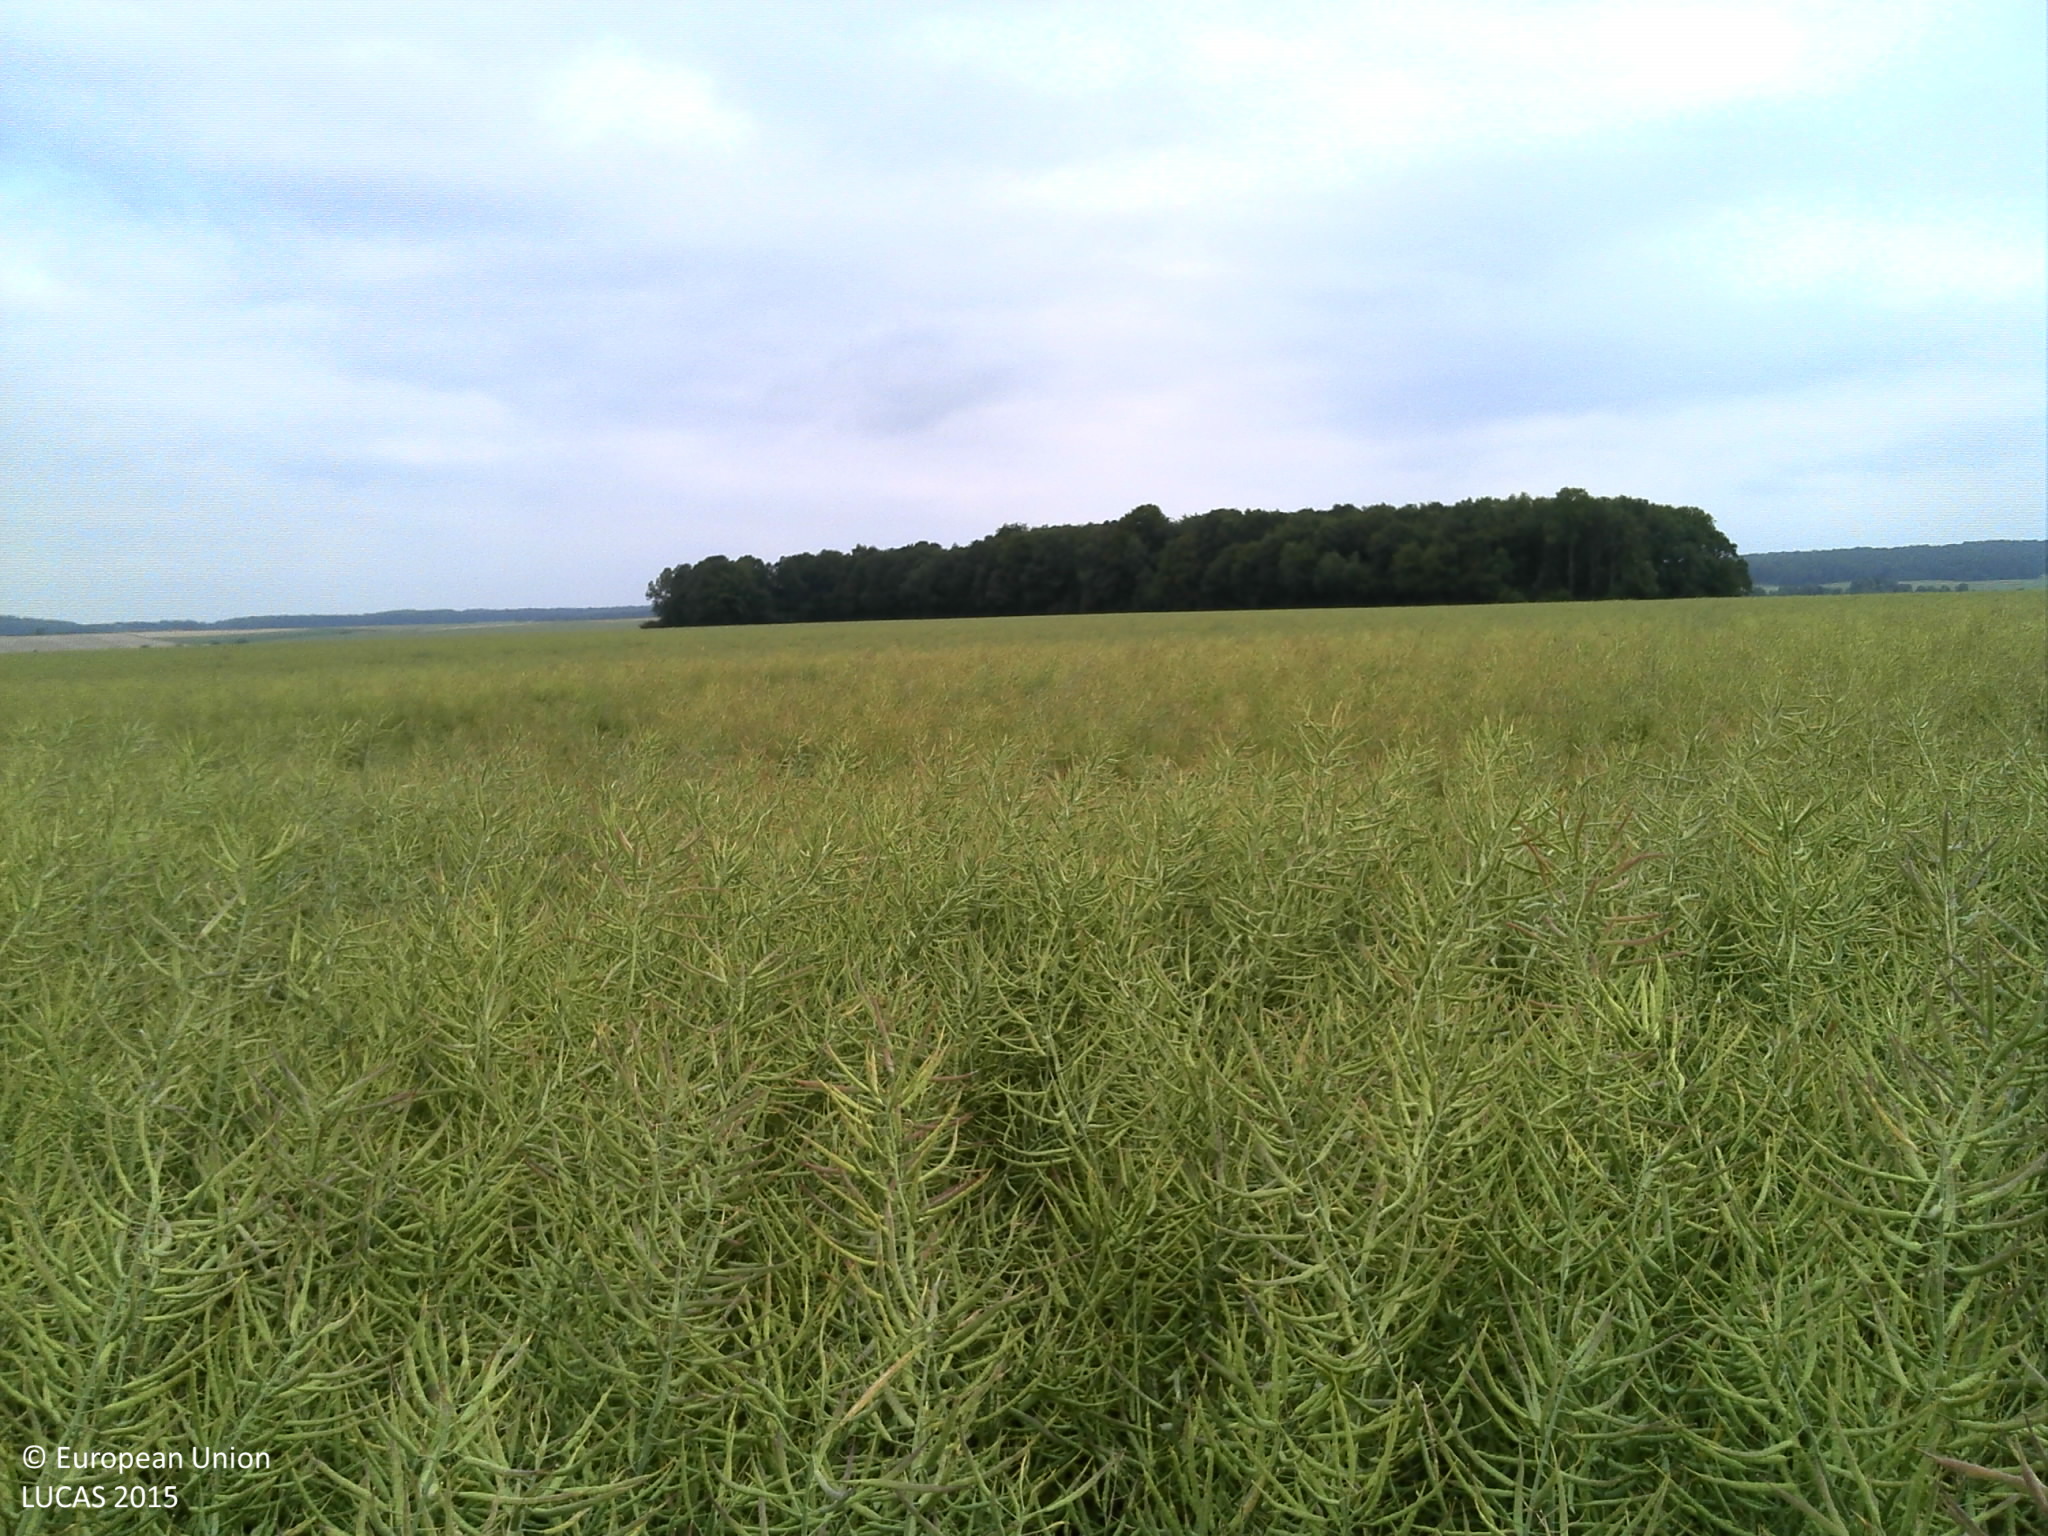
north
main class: Cropland
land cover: Rape and turnip rape
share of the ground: > 75 %
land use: Agriculture (excluding fallow land and kitchen gardens)
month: June
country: FR
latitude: 49.3730
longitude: 5.0259
